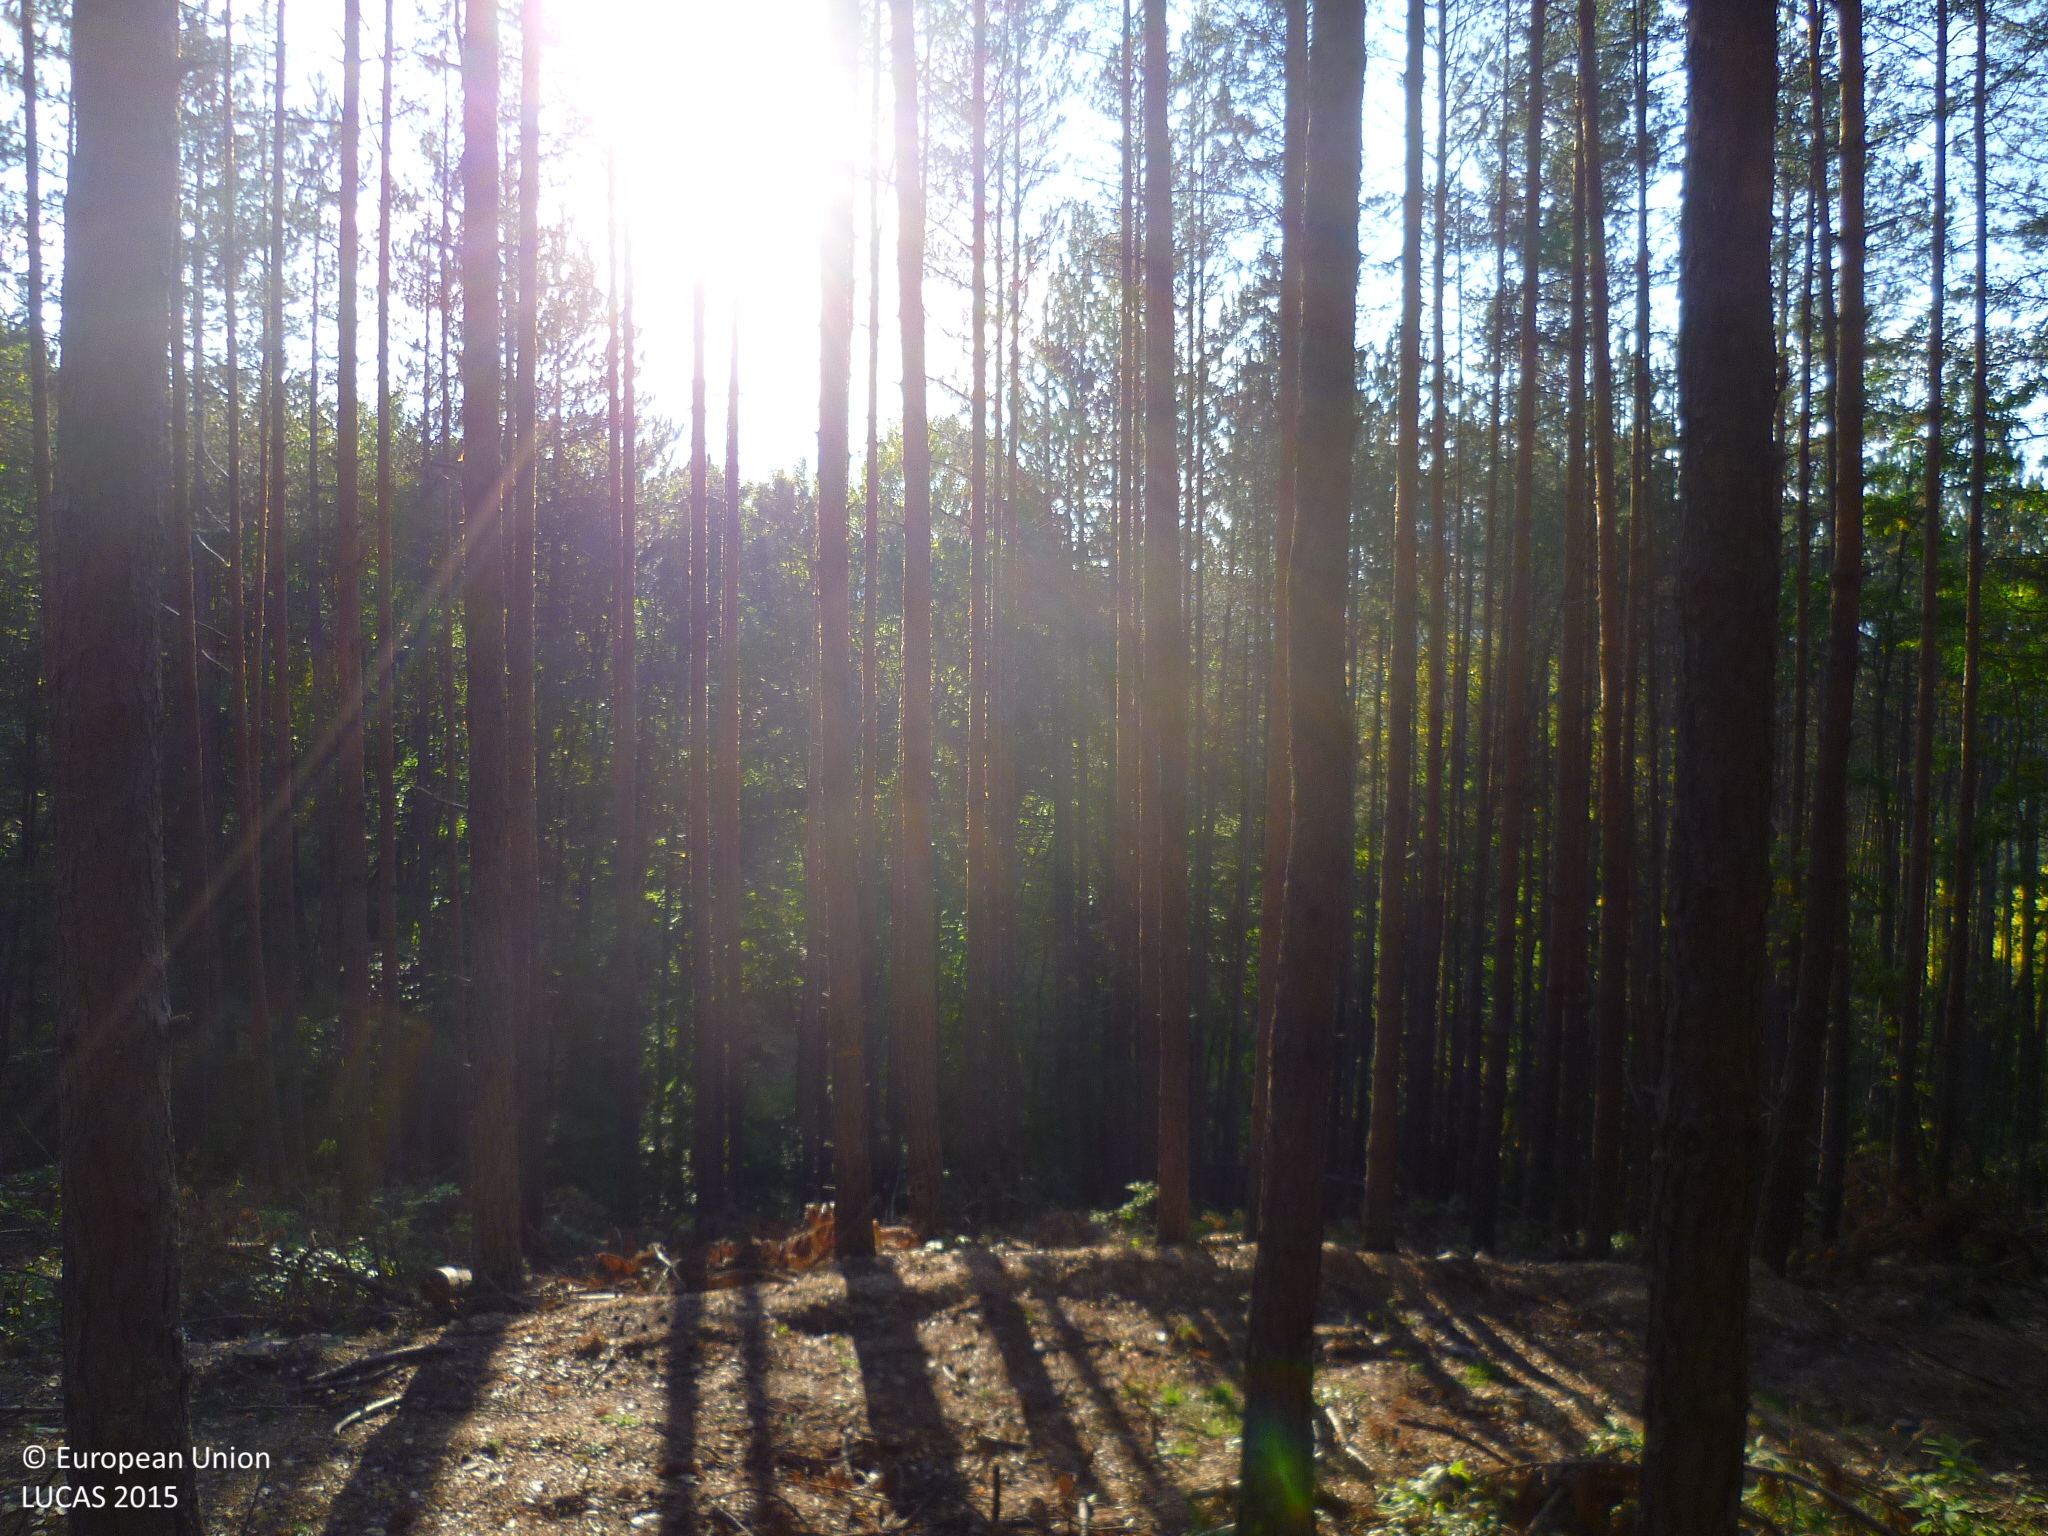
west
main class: Woodland
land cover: Pine dominated mixed woodland
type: hemiboreal forest and nemoral coniferous forest and mixed broadleaved-coniferous forest
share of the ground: > 75 %
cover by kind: coniferous forest trees 60 %, broadleaved forest trees 20 %, unconsolidated bare surface 15 %, herbaceous plants 5 %
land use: Forestry
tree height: > 5 m
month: October
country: BG
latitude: 42.7848
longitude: 22.6783
